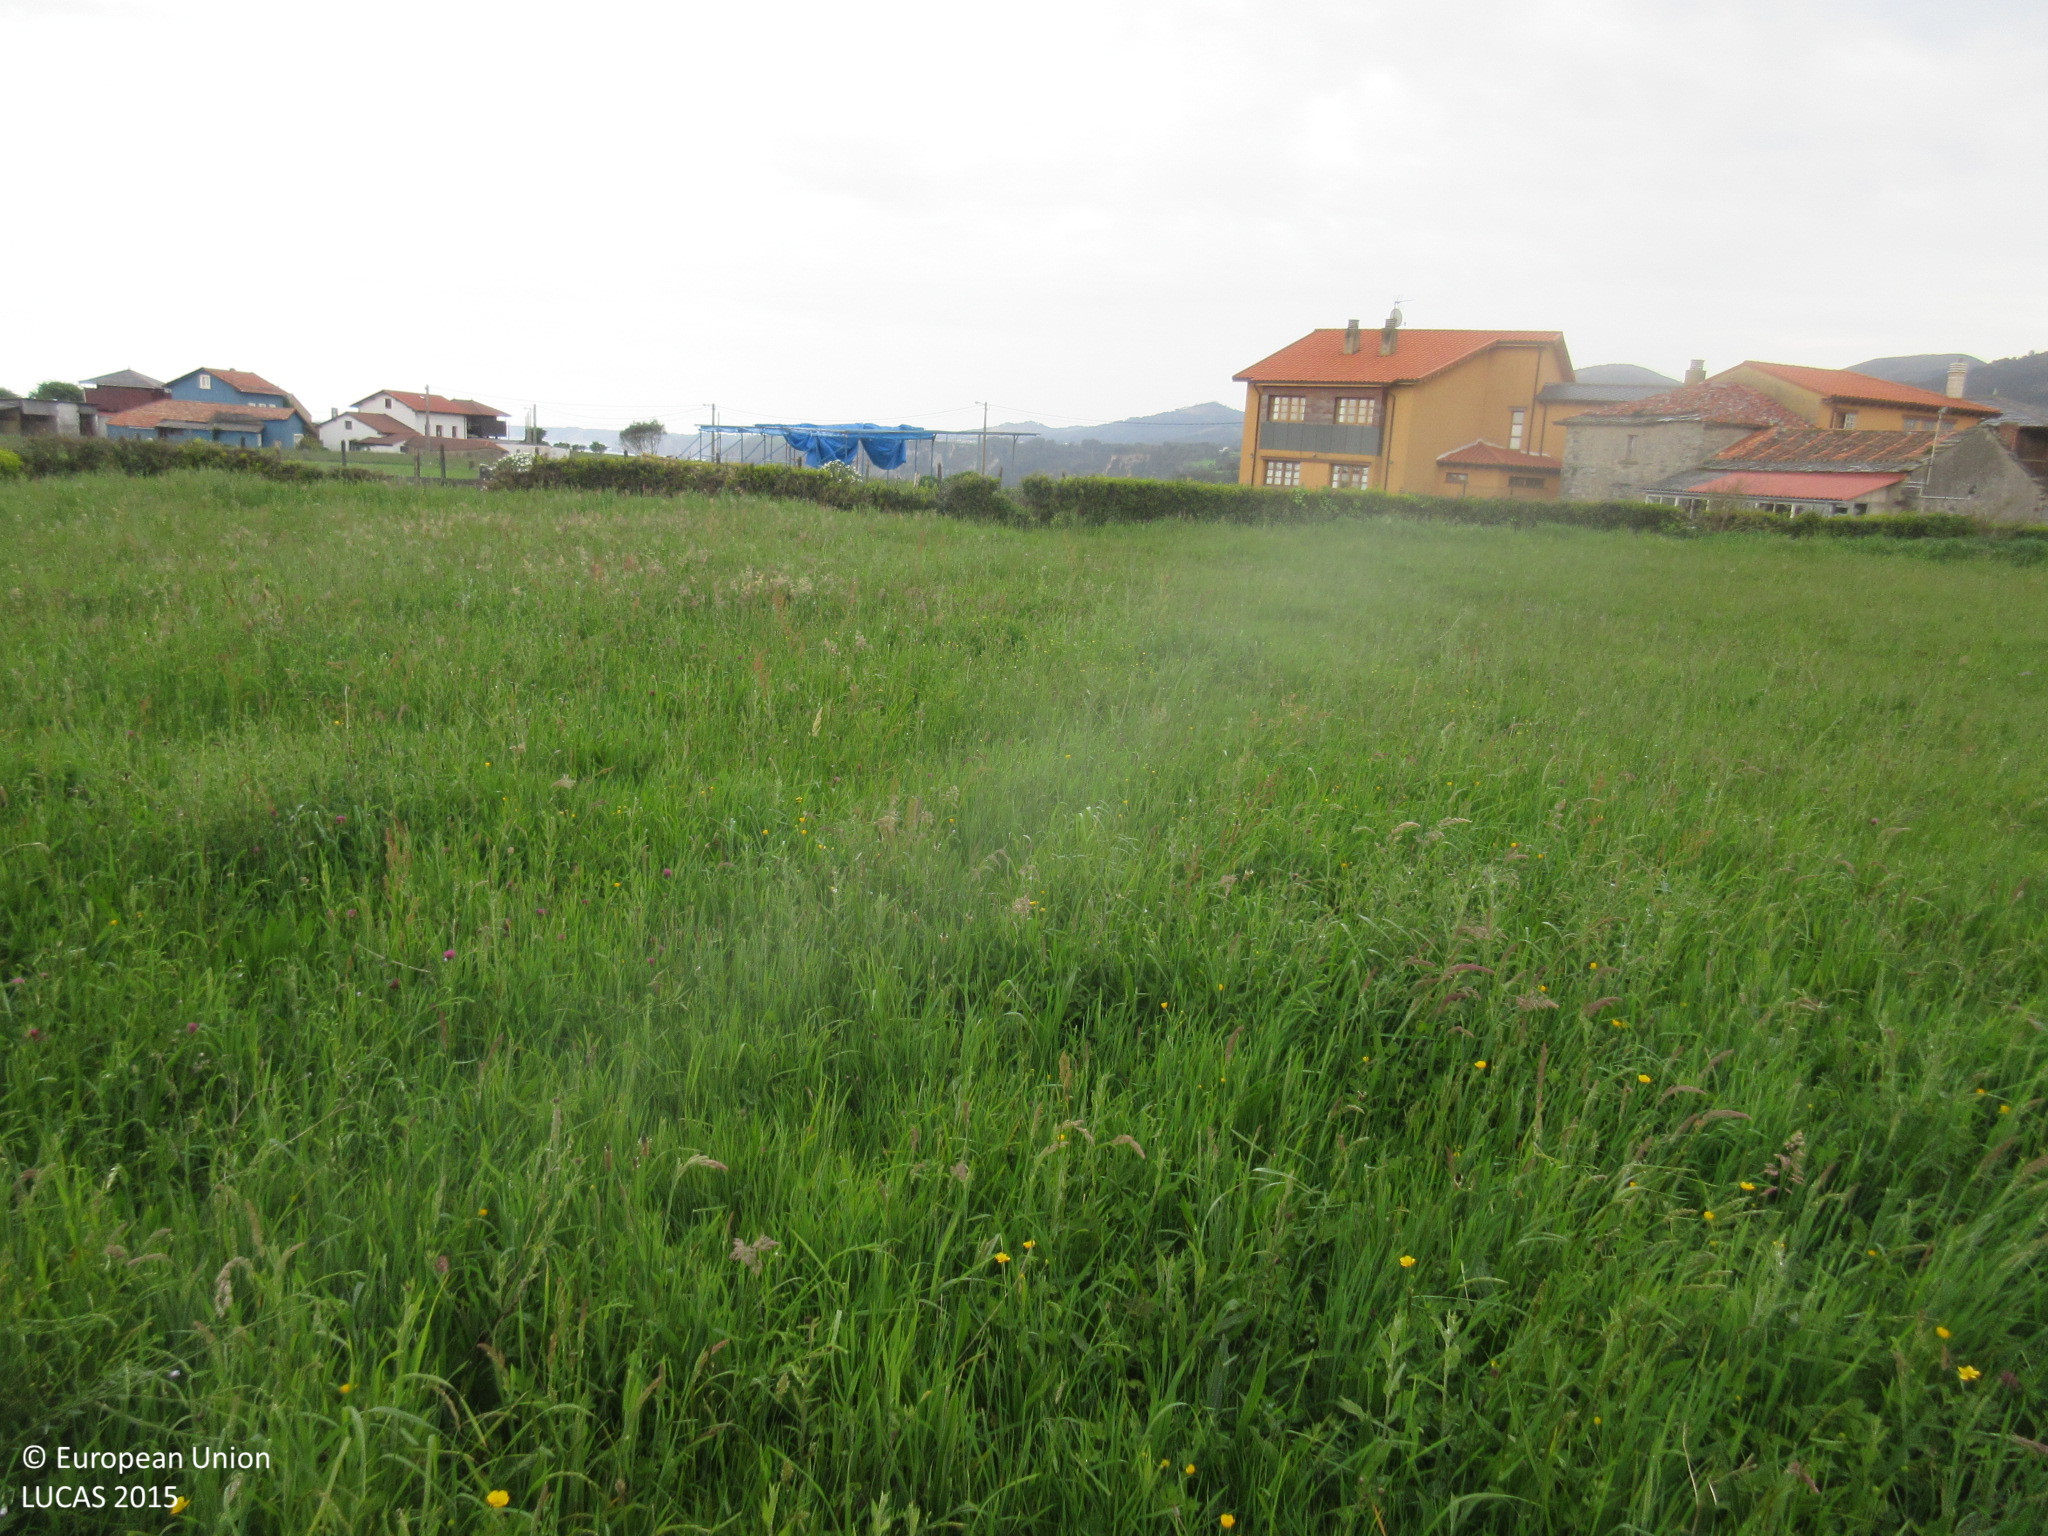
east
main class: Grassland
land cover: Grassland without tree/shrub cover
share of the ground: > 75 %
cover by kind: herbaceous plants 100 %
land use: Agriculture (excluding fallow land and kitchen gardens)
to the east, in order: Grassland without tree/shrub cover; Managed hedges; Grassland without tree/shrub cover; Fences; Grassland without tree/shrub cover; Artificial constructions in urban areas; Grassland without tree/shrub cover; Paved roads, cycling and walking lanes; Grass margins; Electric lines; Fences; Grassland without tree/shrub cover; Fences; Grassland without tree/shrub cover; Fences; Grassland without tree/shrub cover
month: April
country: ES
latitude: 43.5528
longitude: -6.3797
